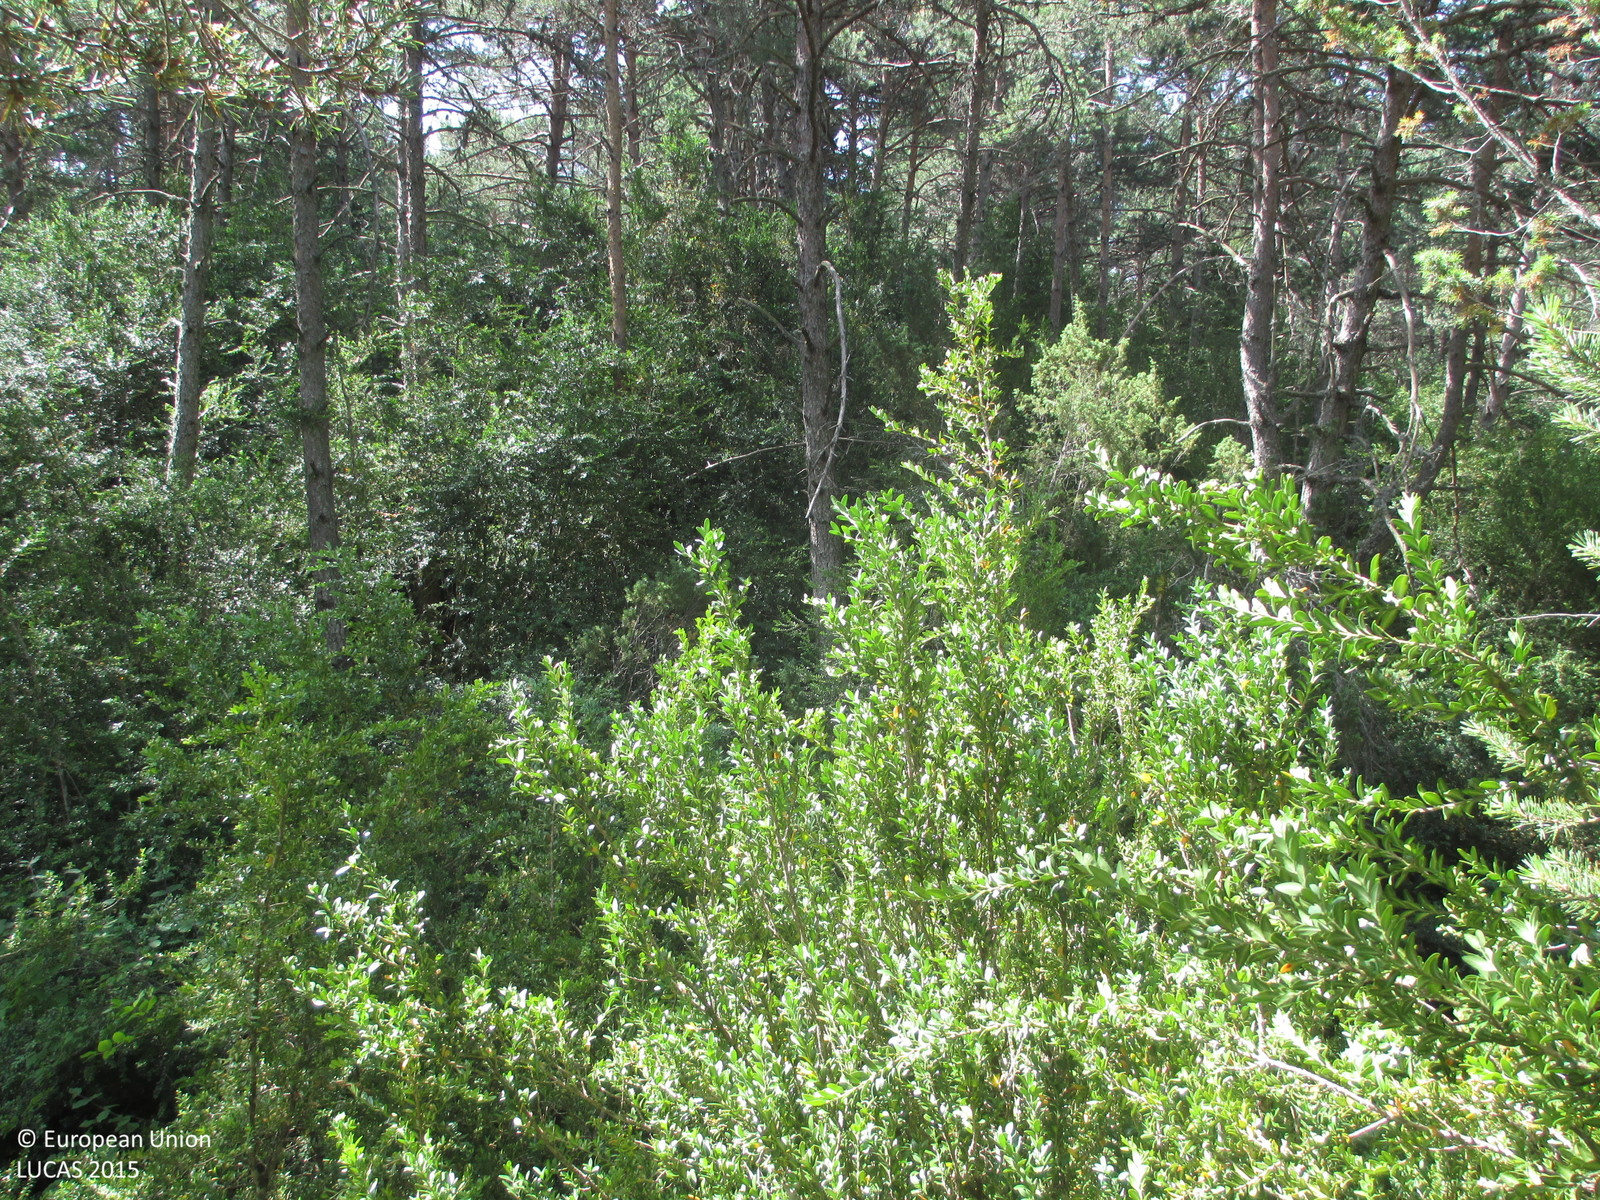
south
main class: Woodland
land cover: Pine dominated coniferous woodland
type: coniferous forest of the mediterranean region
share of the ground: > 75 %
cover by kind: coniferous forest trees 95 %, shrubs 5 %
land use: Semi-natural and natural areas not in use
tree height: > 5 m
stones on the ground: < 10 %
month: July
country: ES
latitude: 42.3503
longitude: -0.2569
